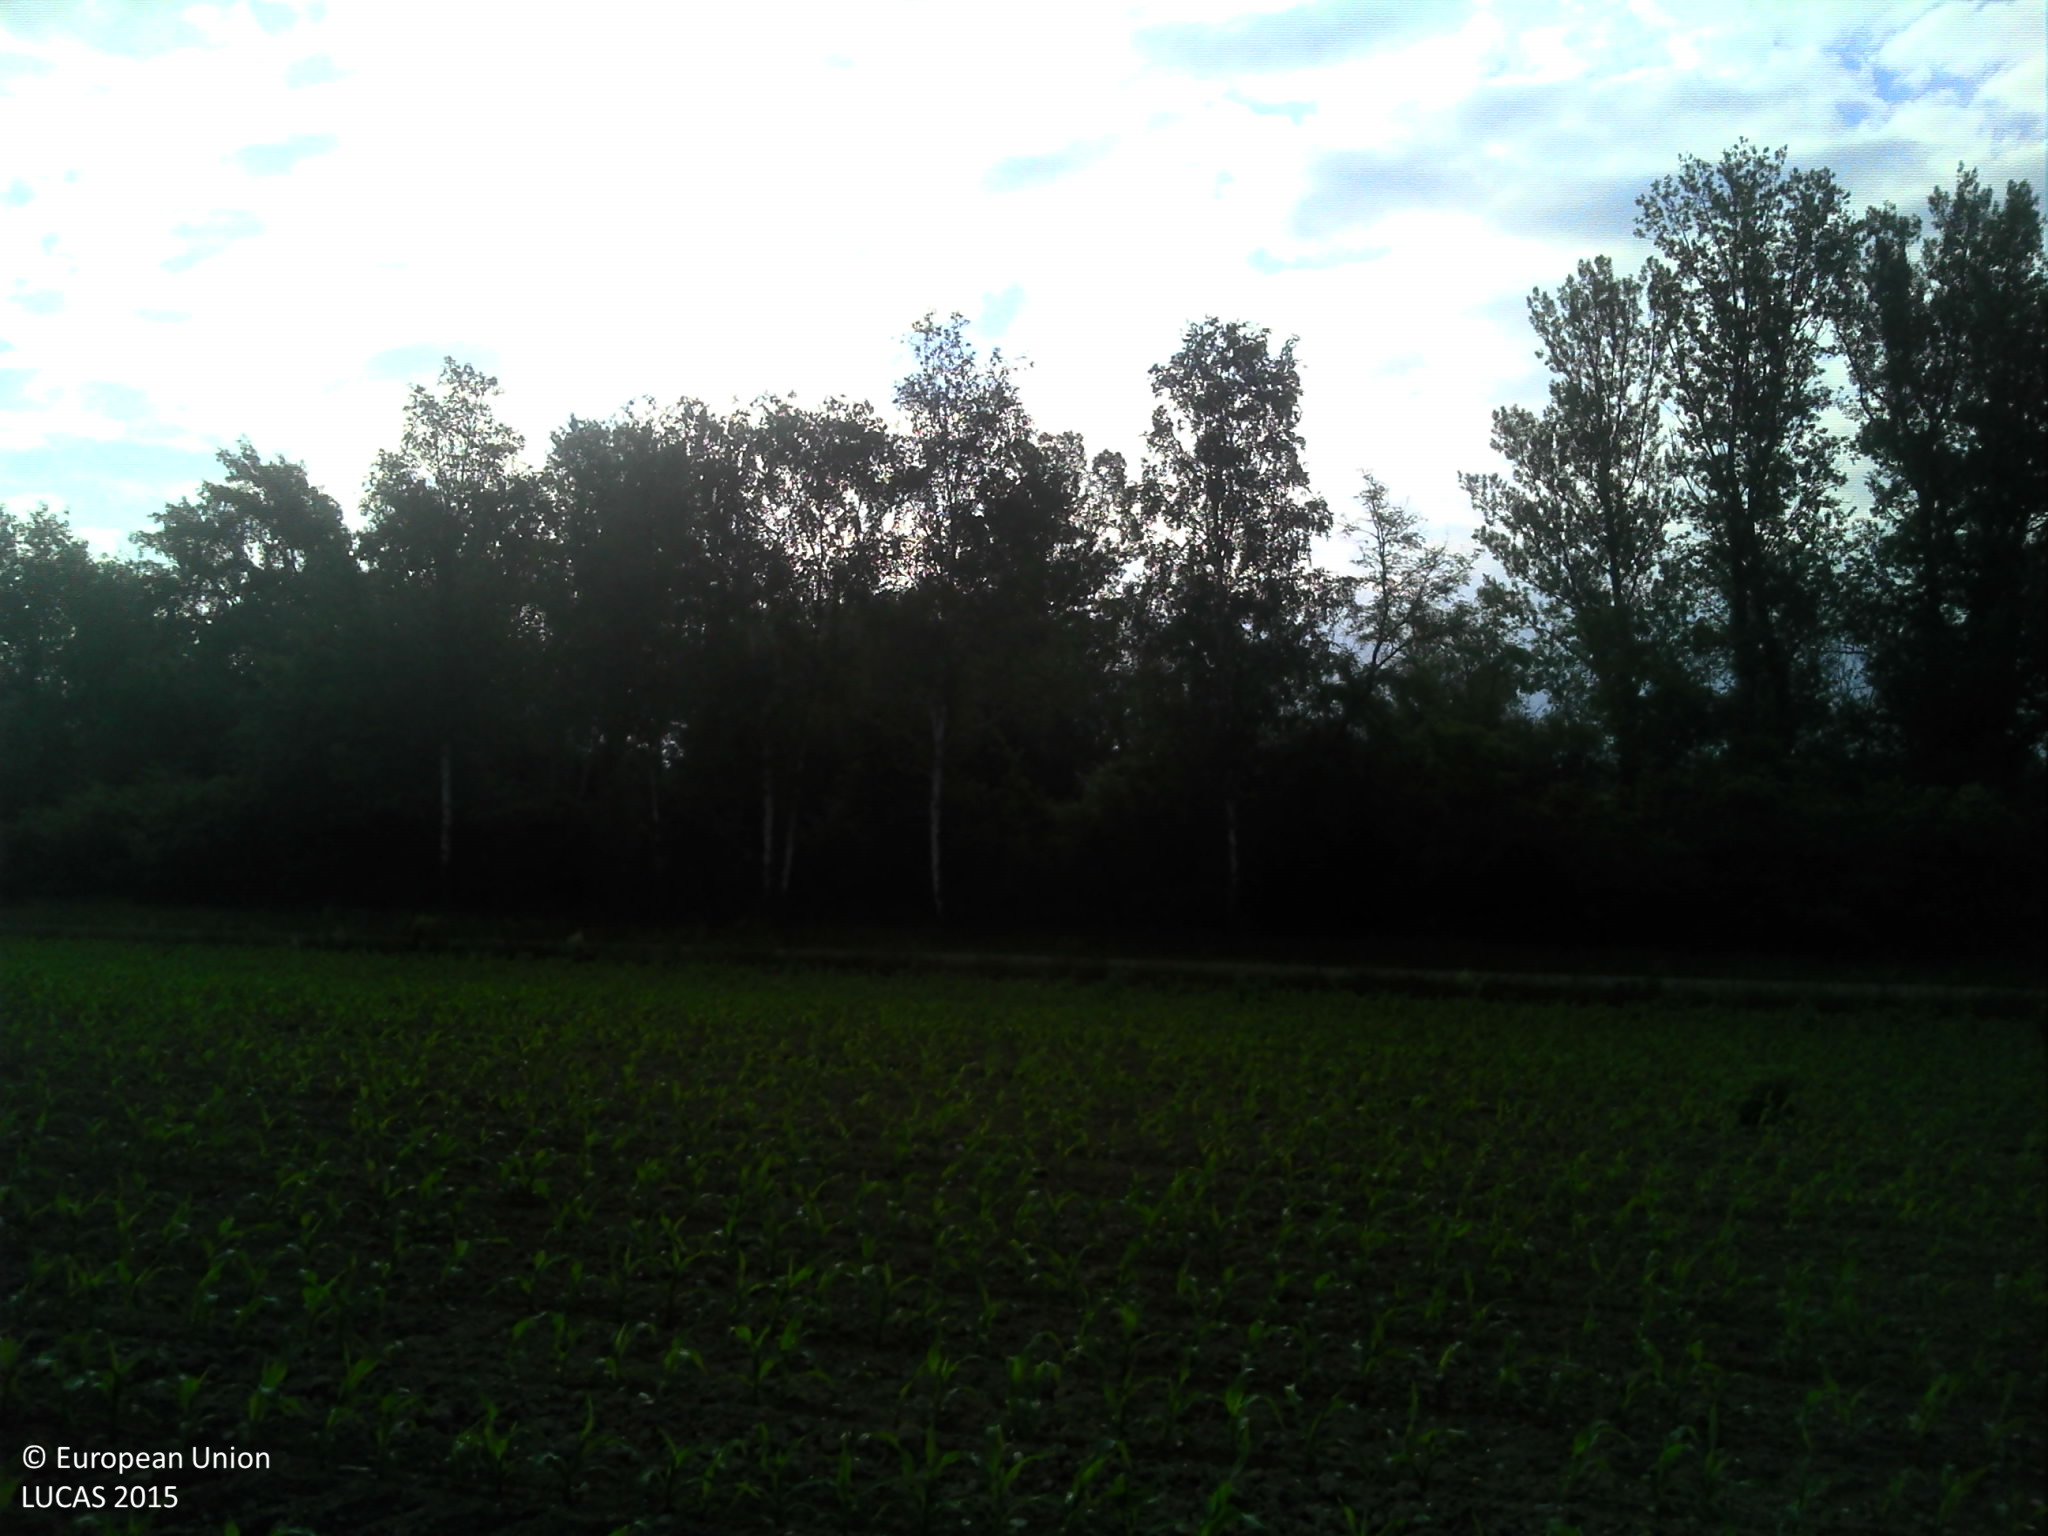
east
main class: Cropland
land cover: Maize
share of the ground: 10 - 25 %
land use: Agriculture (excluding fallow land and kitchen gardens)
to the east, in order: Maize; Electric lines; Maize; Fences; Grass margins; Paved roads, cycling and walking lanes; Grass margins; Managed hedges; Railways; Broadleaved woodland; Tracks; Abandoned hedges; Inland fresh running water; Grass margins; Tracks; Grassland without tree/shrub cover; Tracks; Grass margins; Inland fresh running water
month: May
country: FR
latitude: 48.1247
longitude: 7.5694
